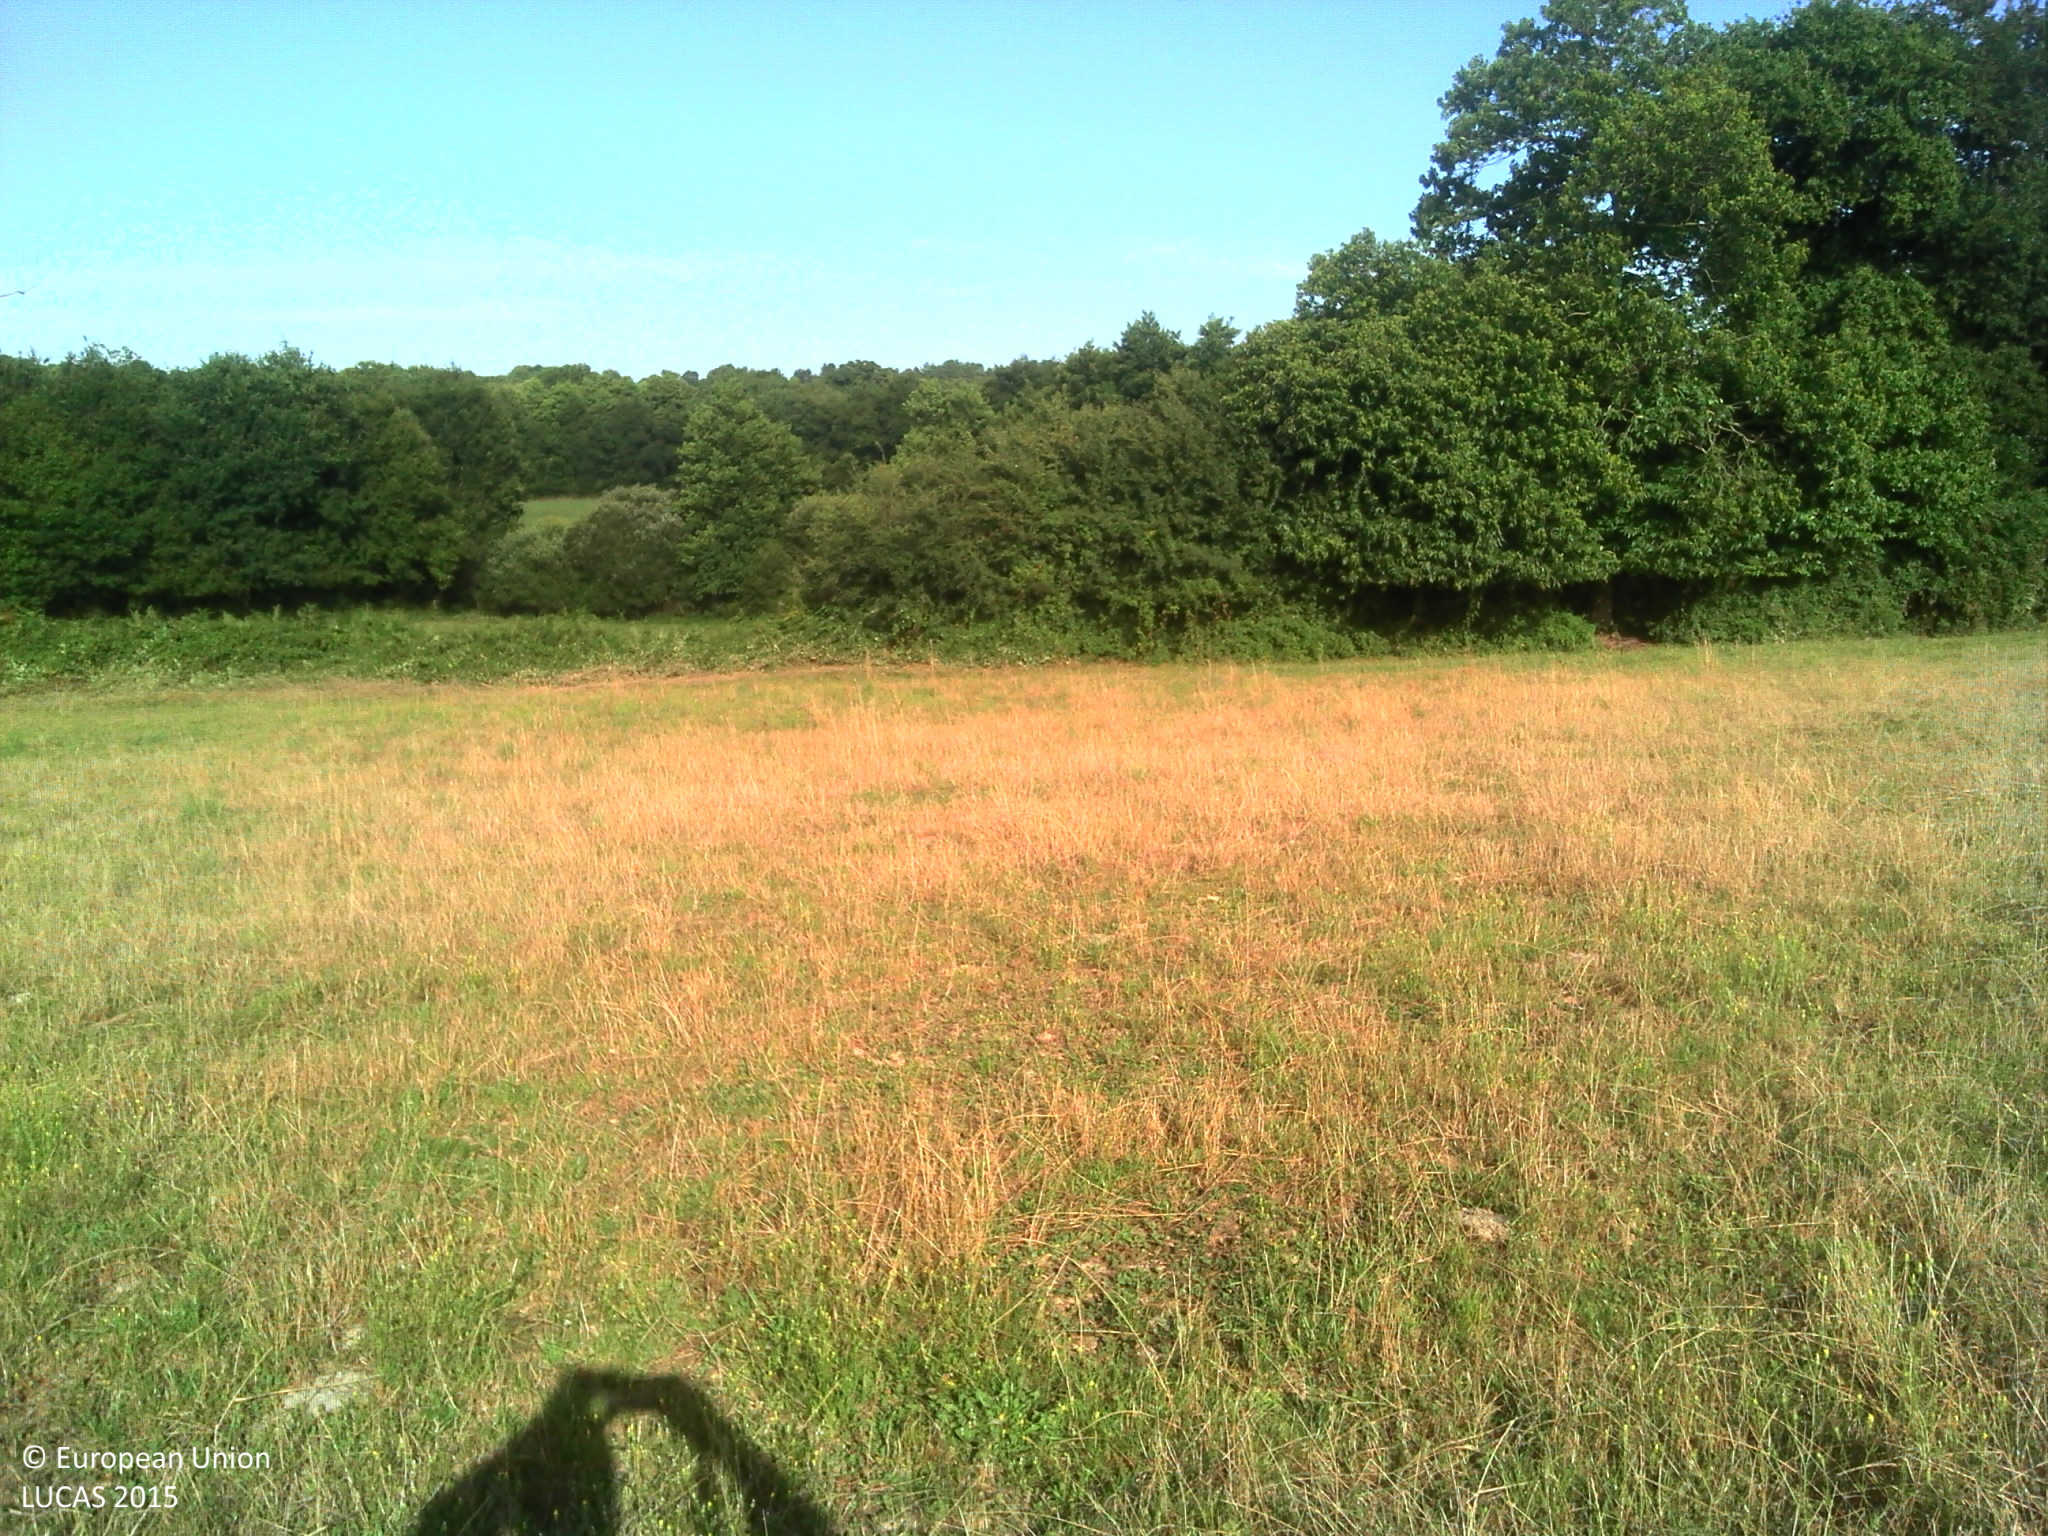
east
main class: Grassland
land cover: Grassland without tree/shrub cover
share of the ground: > 75 %
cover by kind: herbaceous plants 100 %
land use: Agriculture (excluding fallow land and kitchen gardens)
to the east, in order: Grassland without tree/shrub cover; Broadleaved woodland; Grassland without tree/shrub cover; Fences; Broadleaved woodland; Ditches and canals; Grassland without tree/shrub cover; Single bushes/trees; Ditches and canals; Grassland without tree/shrub cover
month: August
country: FR
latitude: 46.6515
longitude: -1.7097
